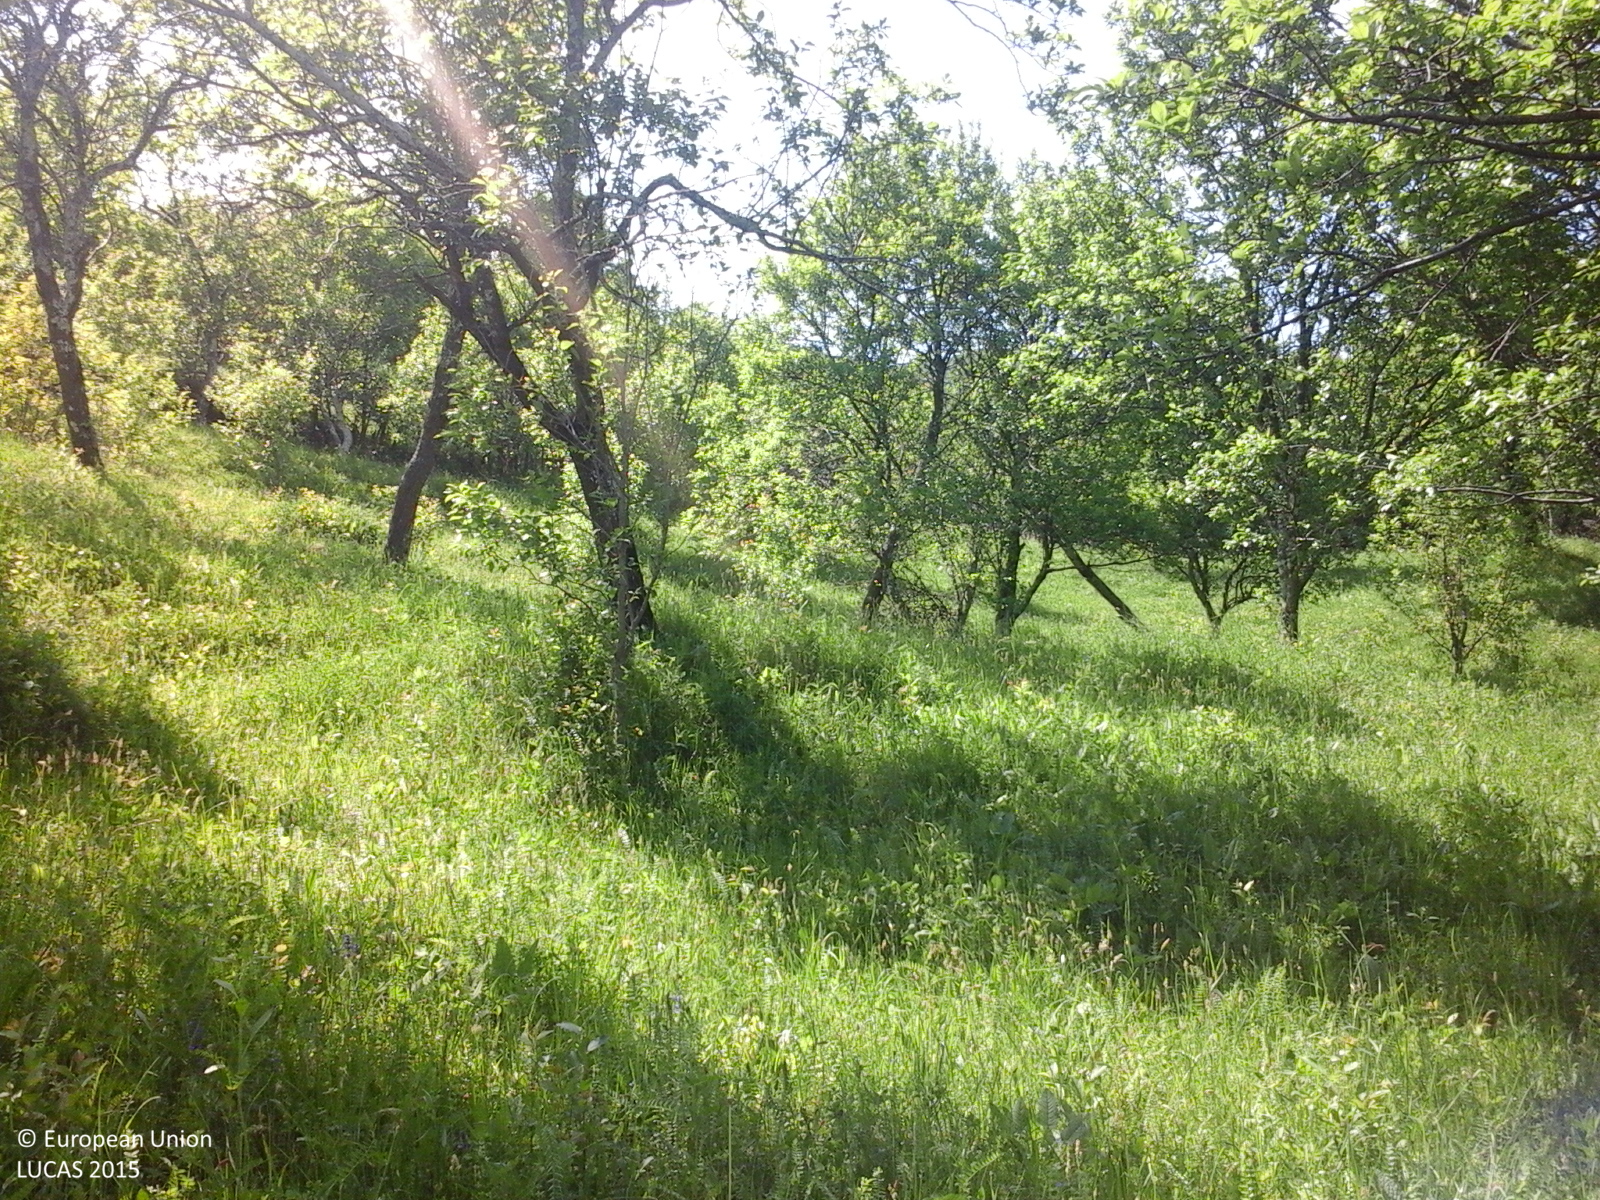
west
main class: Cropland
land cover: Other fruit trees and berries
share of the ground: 50 - 75 %
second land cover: Grassland without tree/shrub cover
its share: > 75 %
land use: Agriculture (excluding fallow land and kitchen gardens)
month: May
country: RO
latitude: 45.4772
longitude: 26.4077
